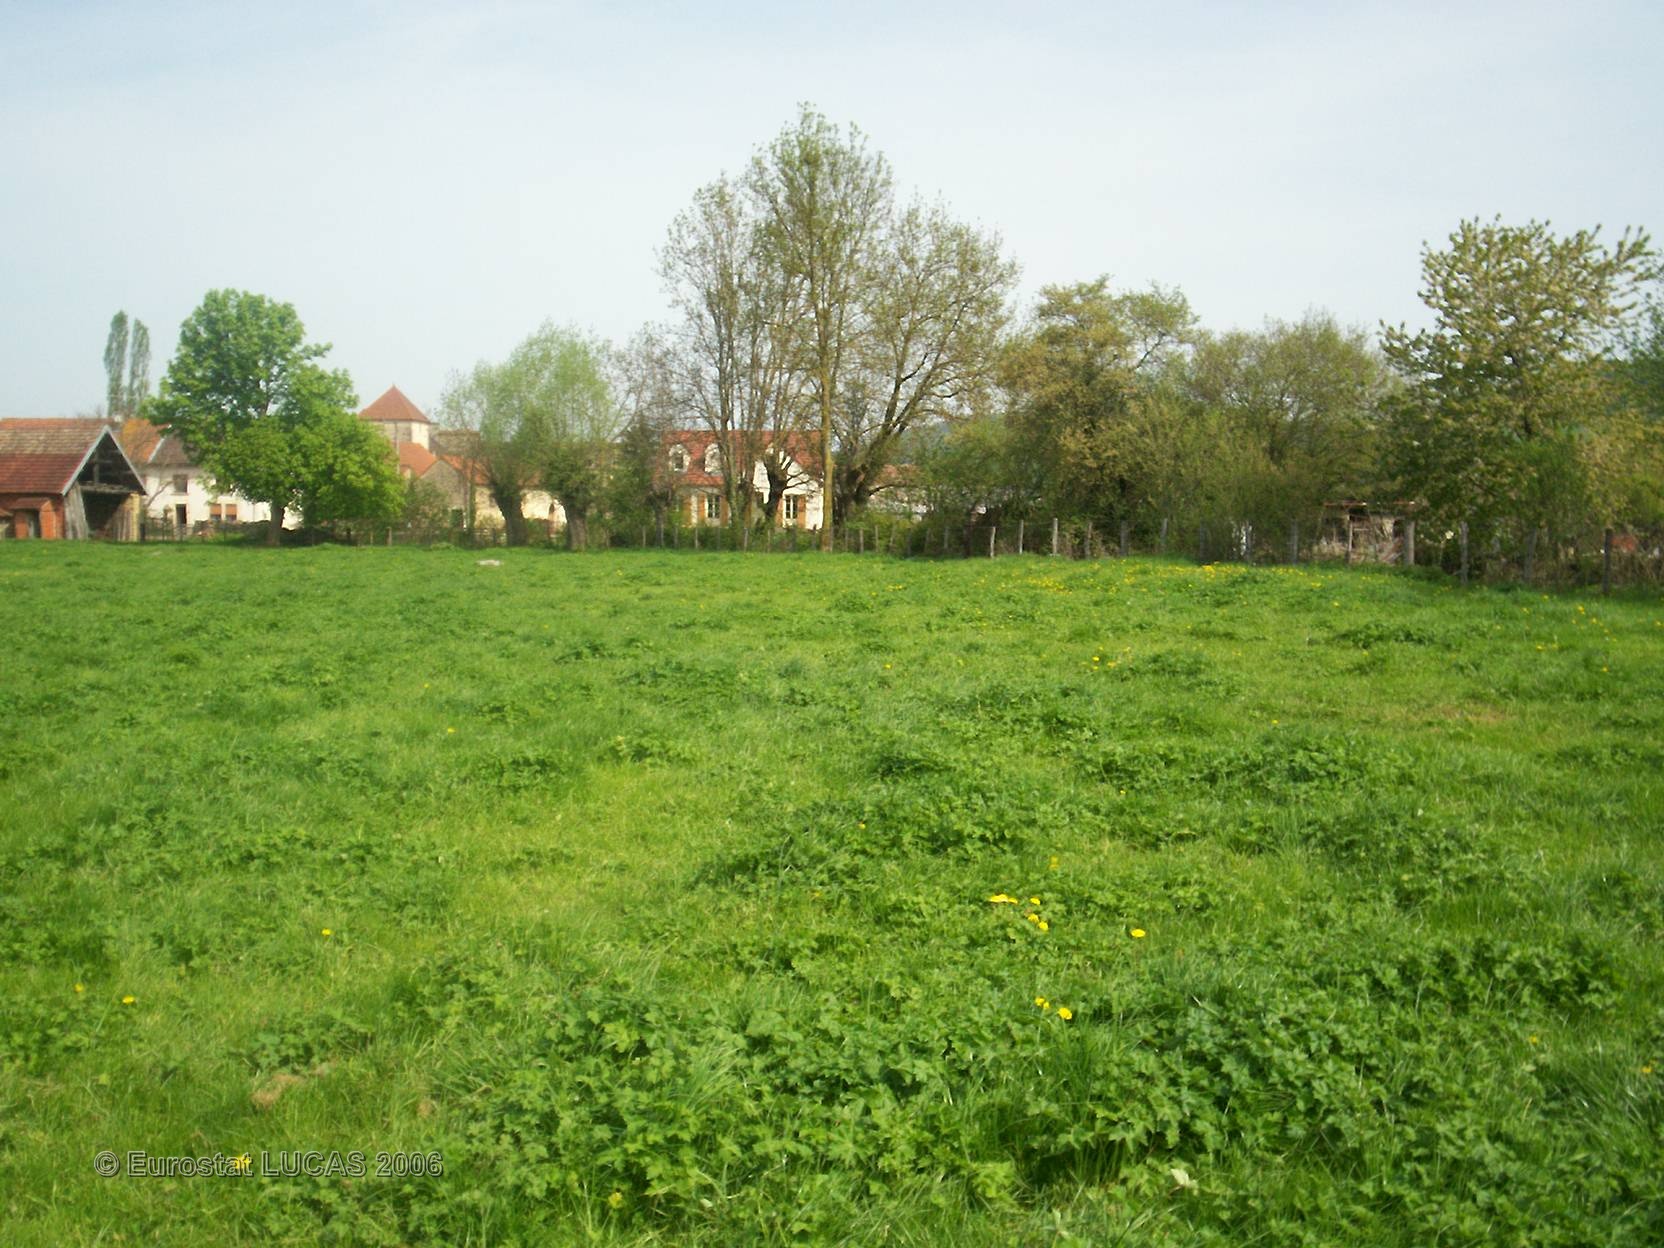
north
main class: Grassland
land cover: Grassland without tree/shrub cover
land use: Agriculture (excluding fallow land and kitchen gardens)
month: May
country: FR
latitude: 47.4420
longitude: 4.6023
